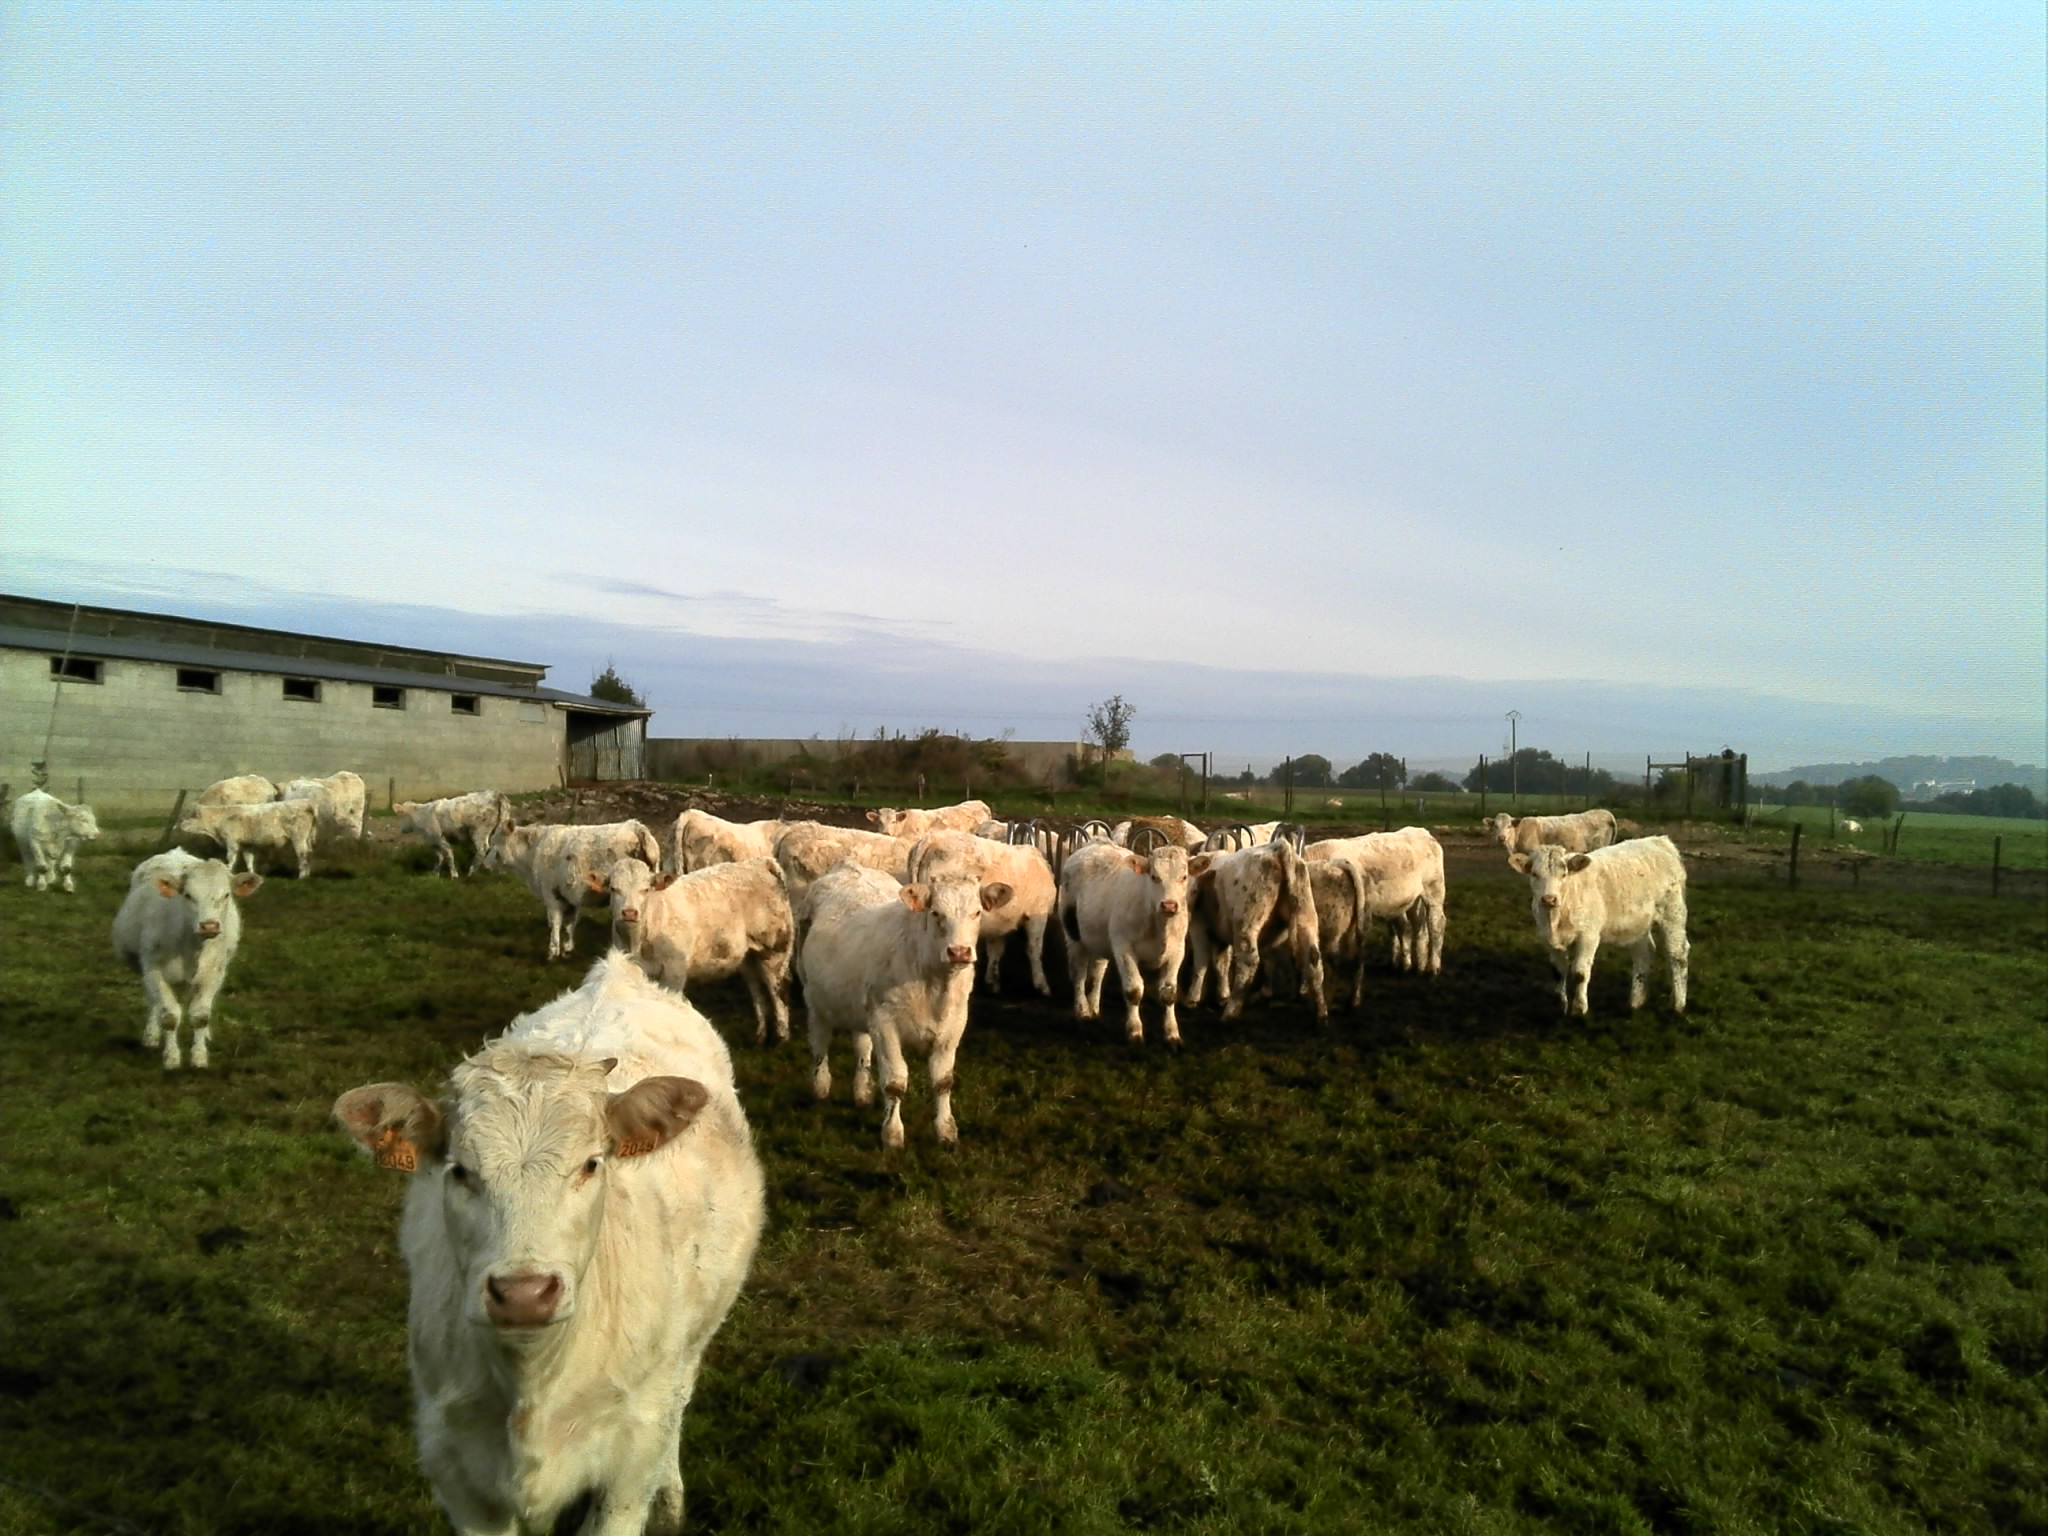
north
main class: Grassland
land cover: Grassland without tree/shrub cover
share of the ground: > 75 %
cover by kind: herbaceous plants 100 %
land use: Agriculture (excluding fallow land and kitchen gardens)
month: October
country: FR
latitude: 47.2724
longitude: -0.9935
